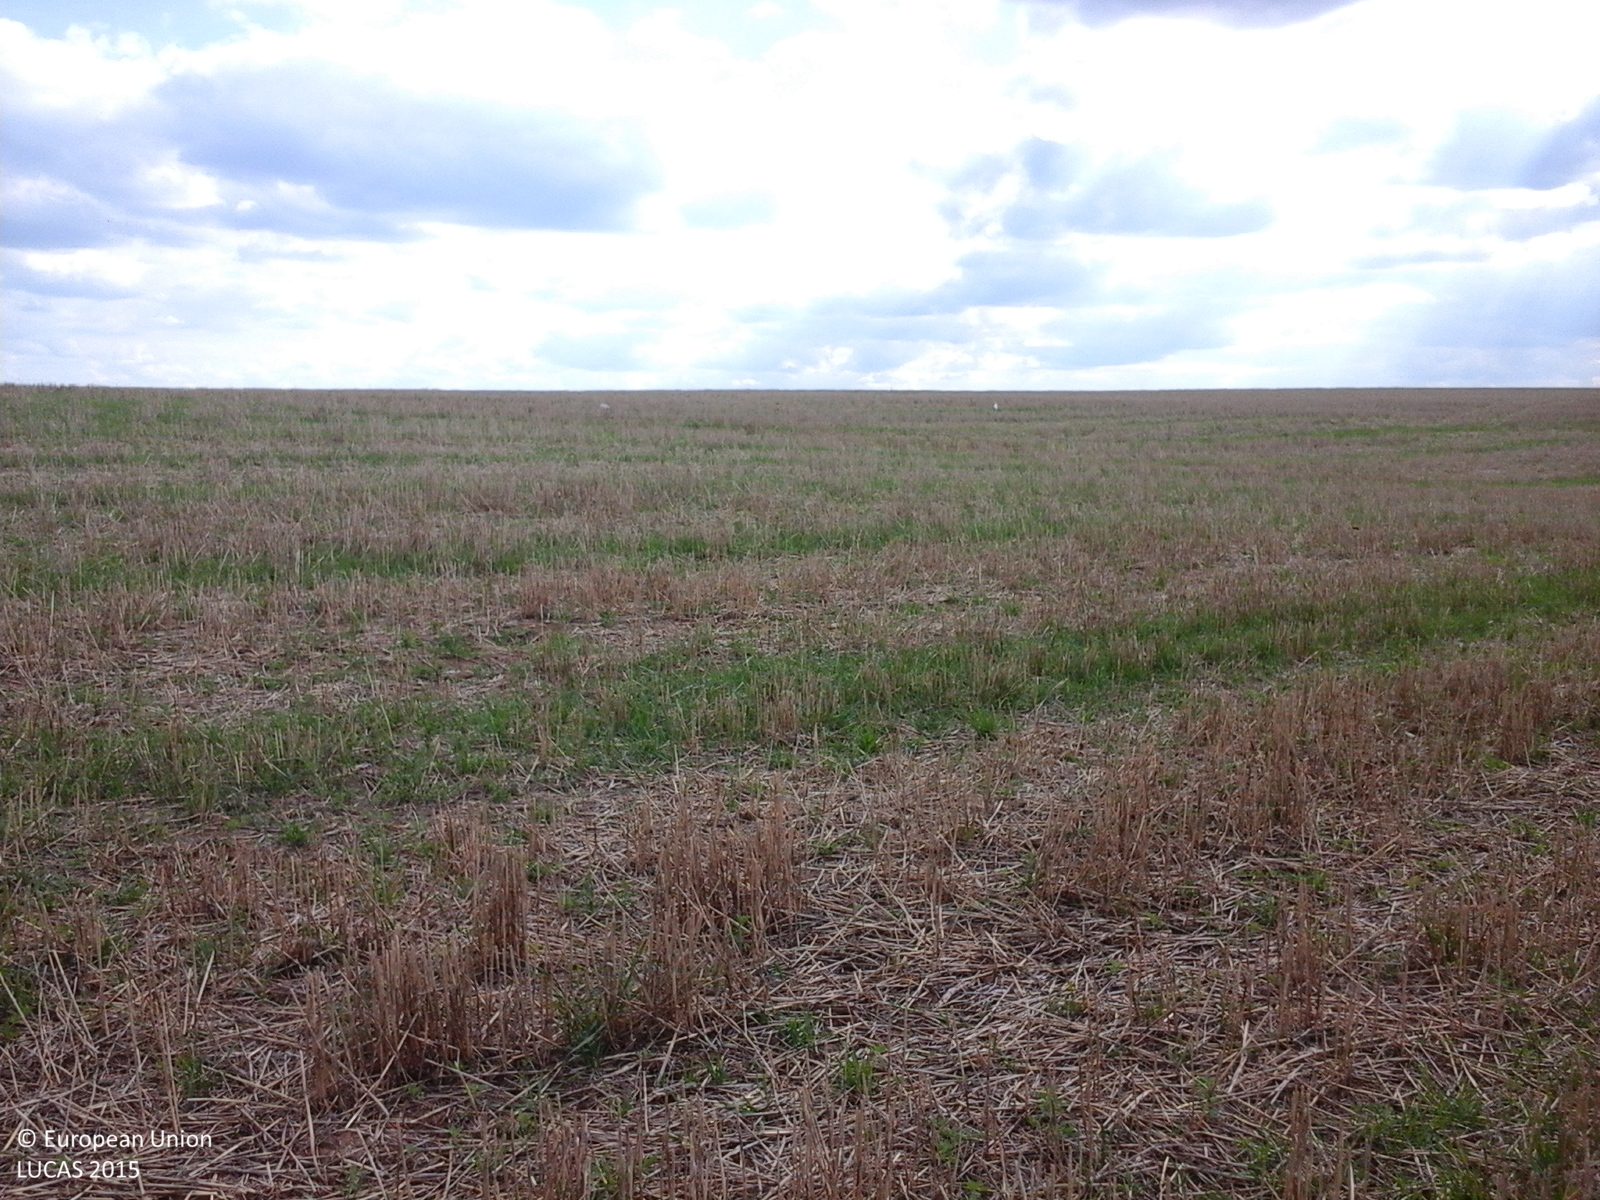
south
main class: Cropland
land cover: Common wheat
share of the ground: 50 - 75 %
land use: Agriculture (excluding fallow land and kitchen gardens)
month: September
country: RO
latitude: 47.4614
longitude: 22.5942
